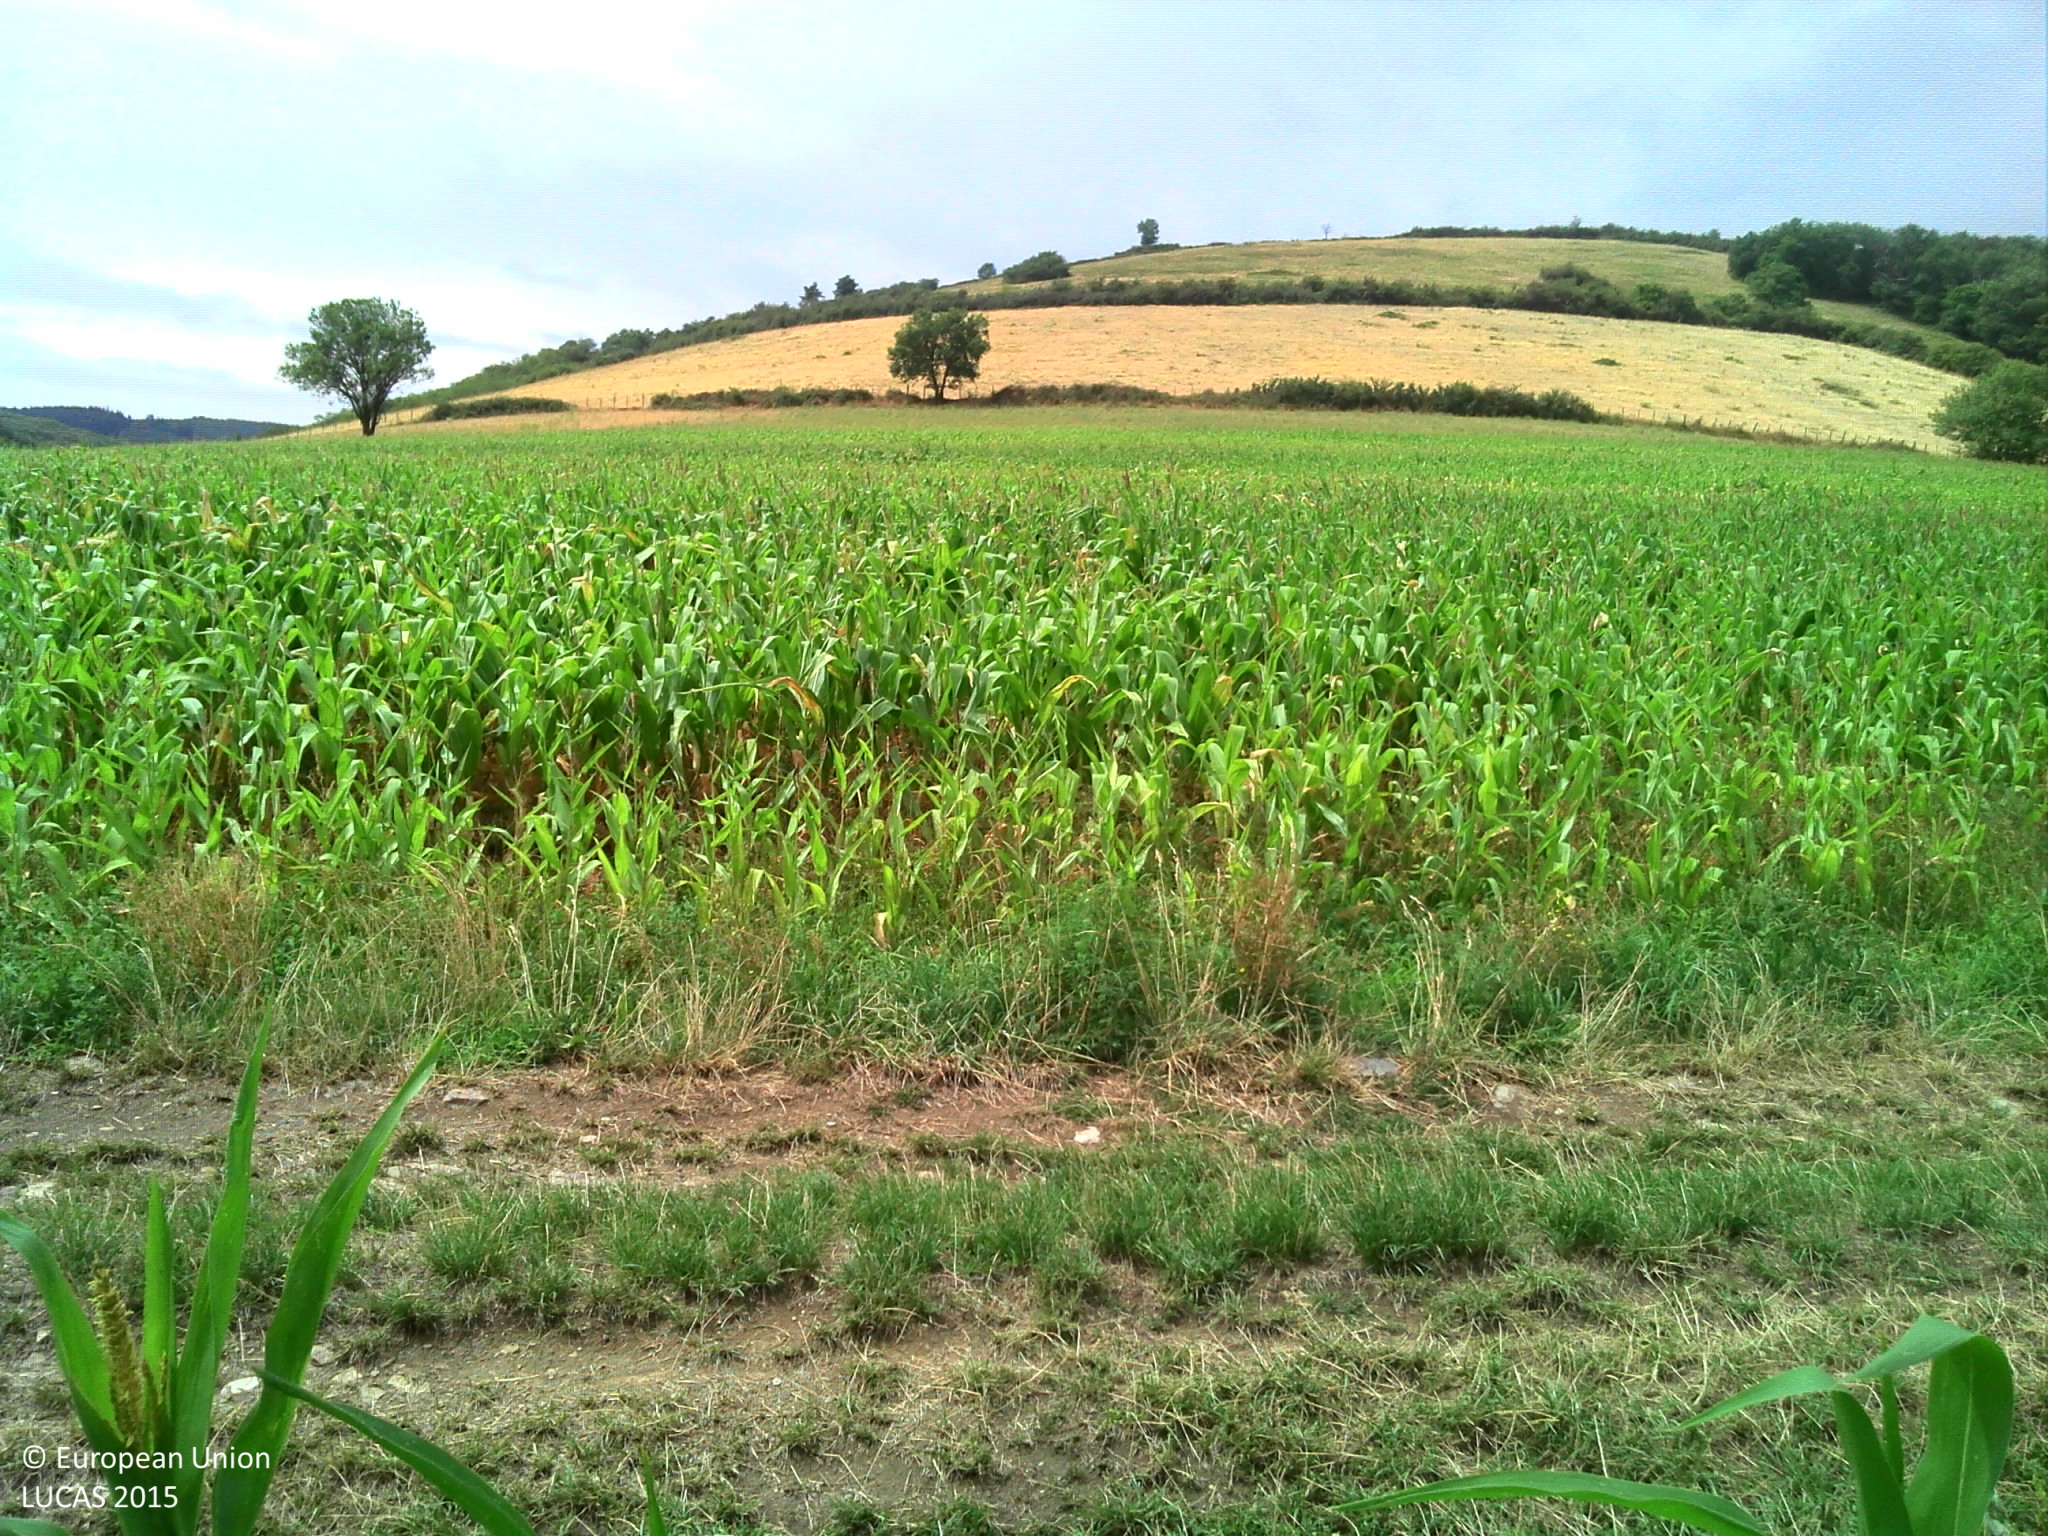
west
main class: Cropland
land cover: Maize
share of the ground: > 75 %
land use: Agriculture (excluding fallow land and kitchen gardens)
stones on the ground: 25 - 50 %
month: August
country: FR
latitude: 45.4986
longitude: 4.7188
